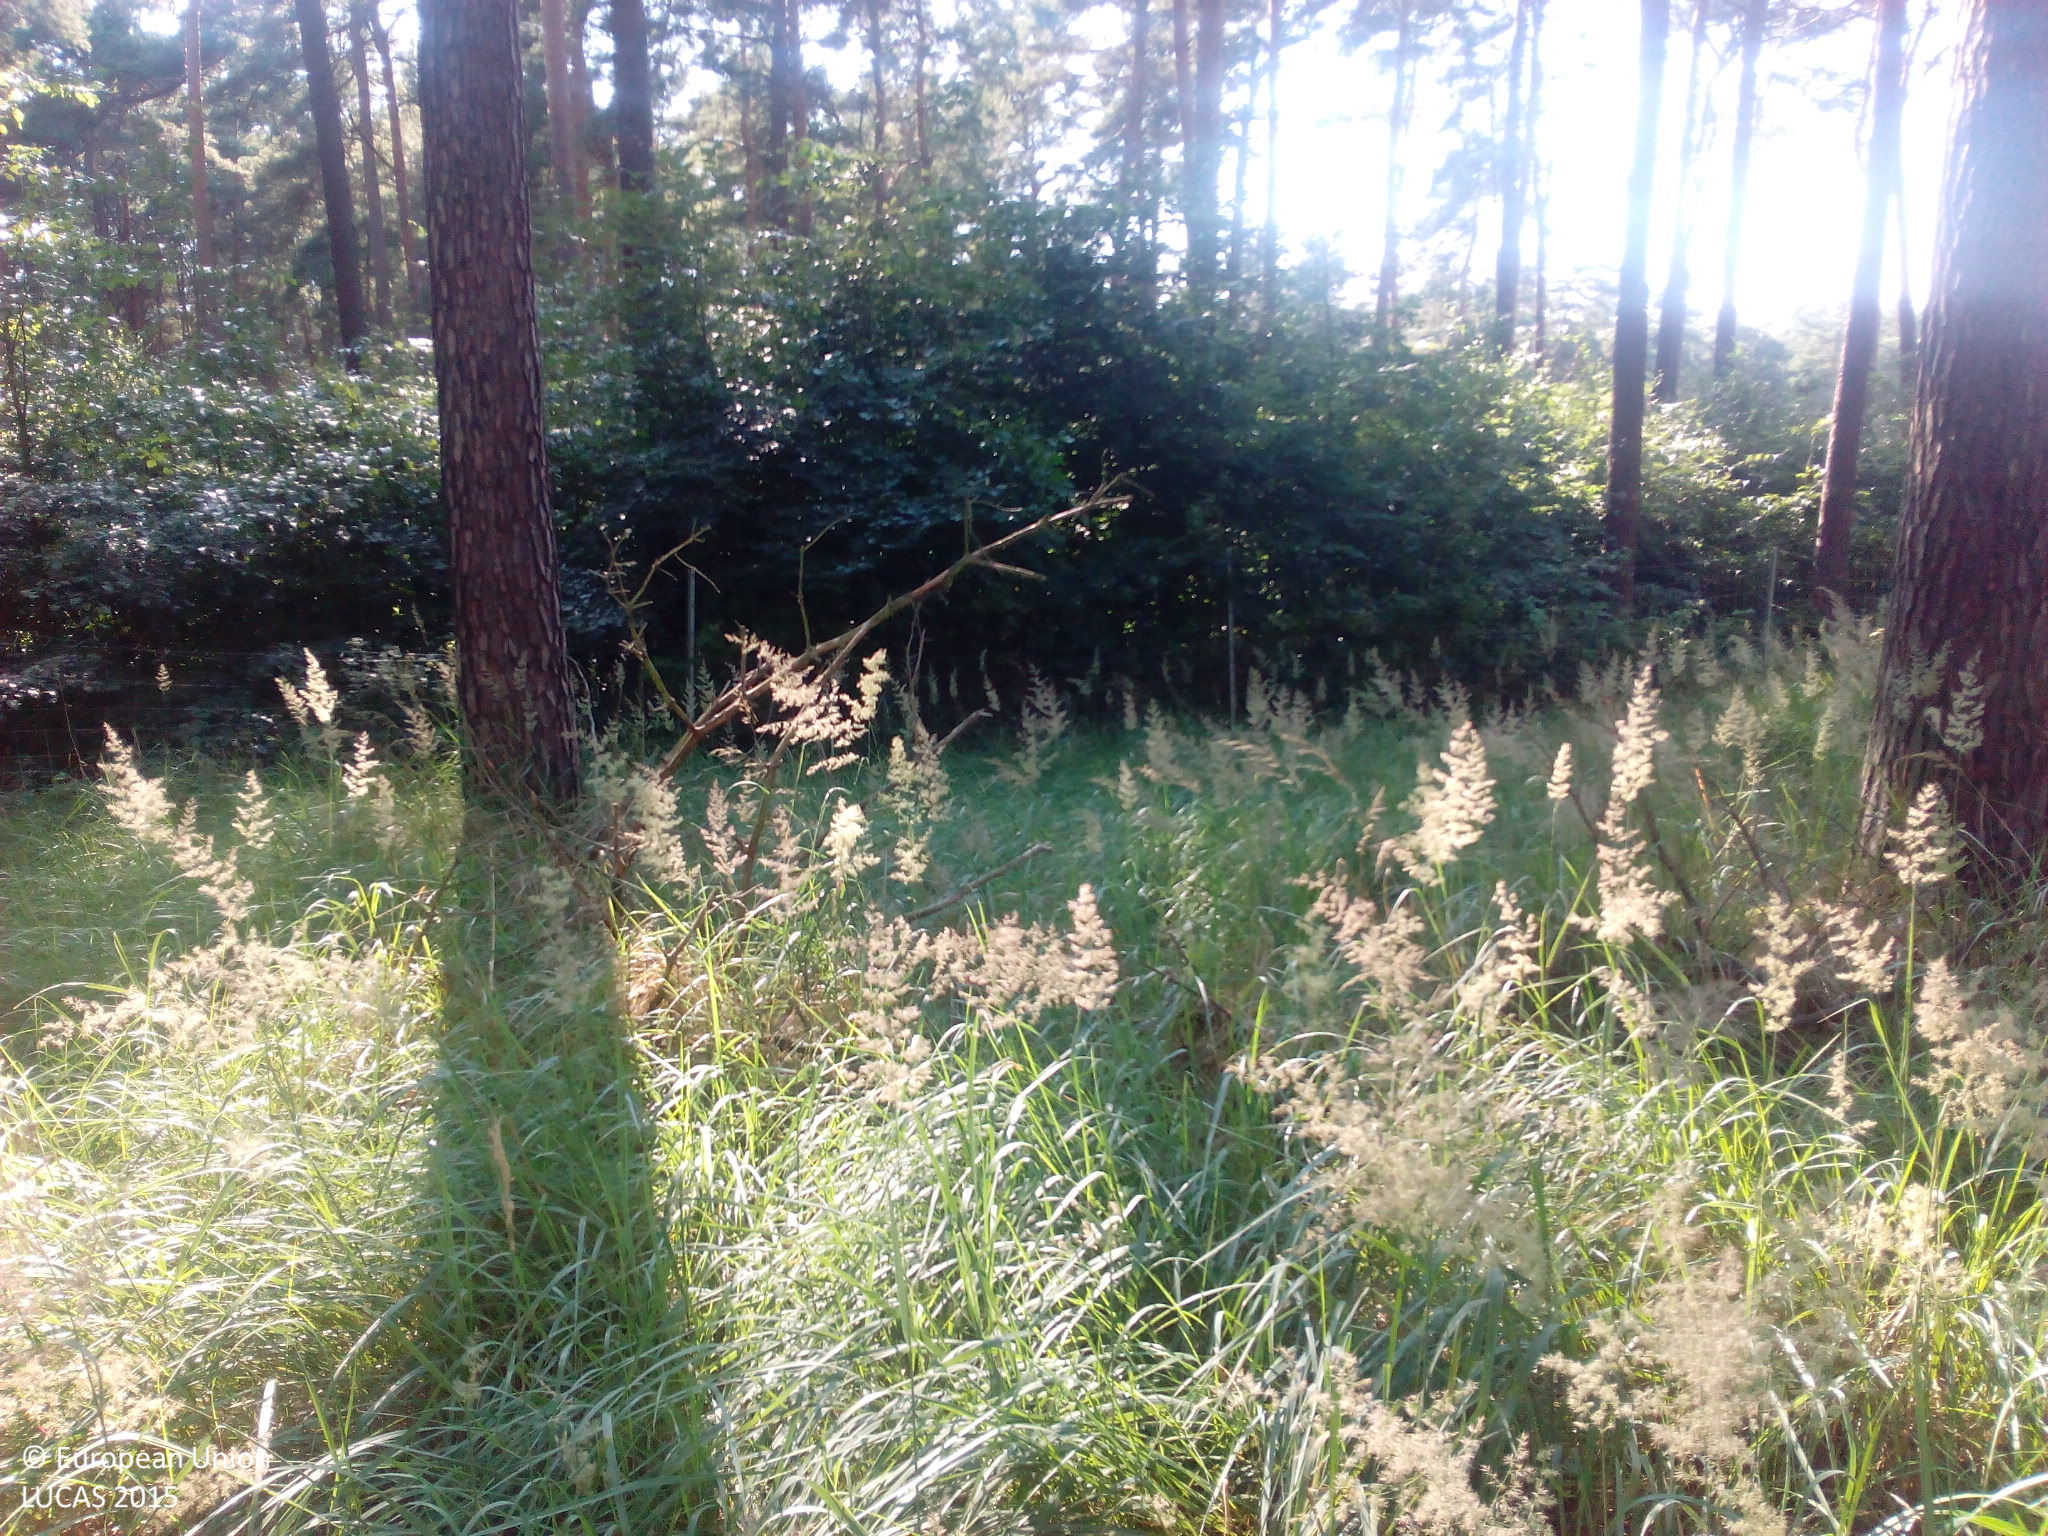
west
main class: Woodland
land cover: Pine dominated mixed woodland
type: hemiboreal forest and nemoral coniferous forest and mixed broadleaved-coniferous forest
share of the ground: > 75 %
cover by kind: coniferous forest trees 70 %, broadleaved forest trees 30 %
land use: Forestry
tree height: > 5 m
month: July
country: DE
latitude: 51.9725
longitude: 12.5472
